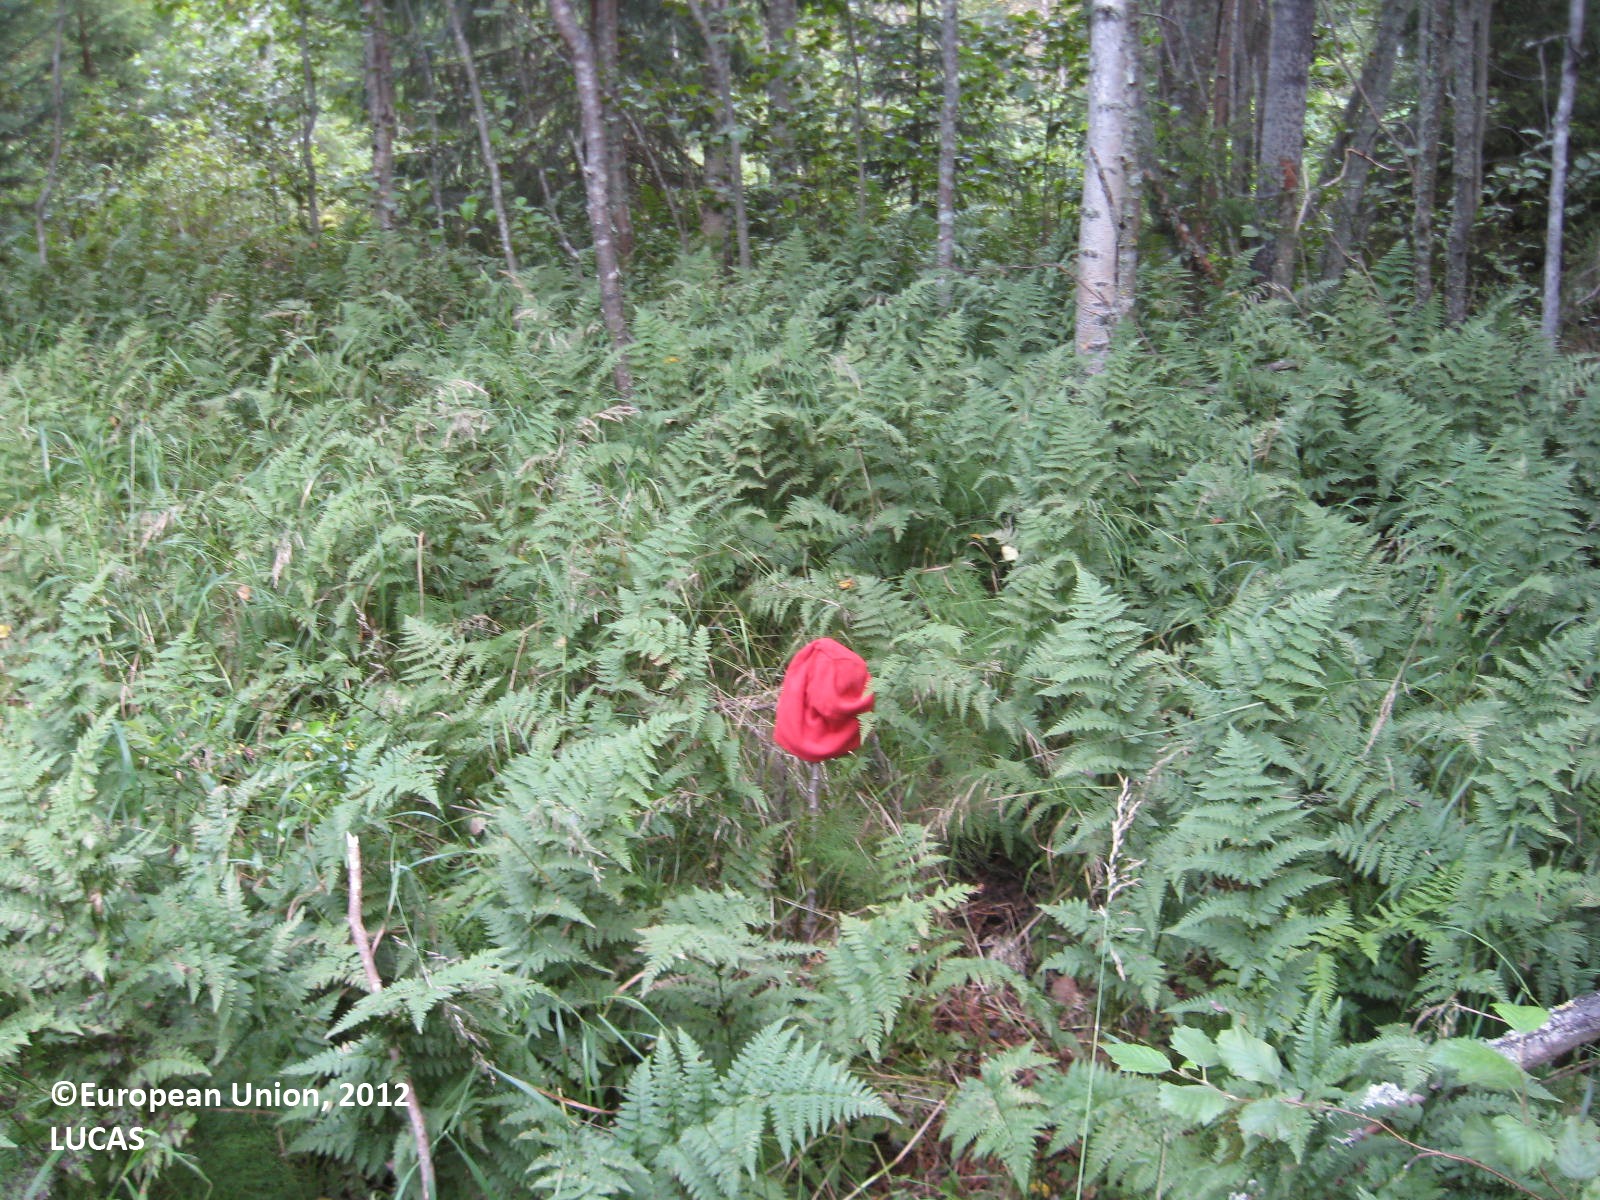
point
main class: Woodland
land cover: Broadleaved woodland
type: boreal forest
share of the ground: 50 - 75 %
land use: Forestry
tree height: > 5 m
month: August
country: FI
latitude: 63.4168
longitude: 29.6010
